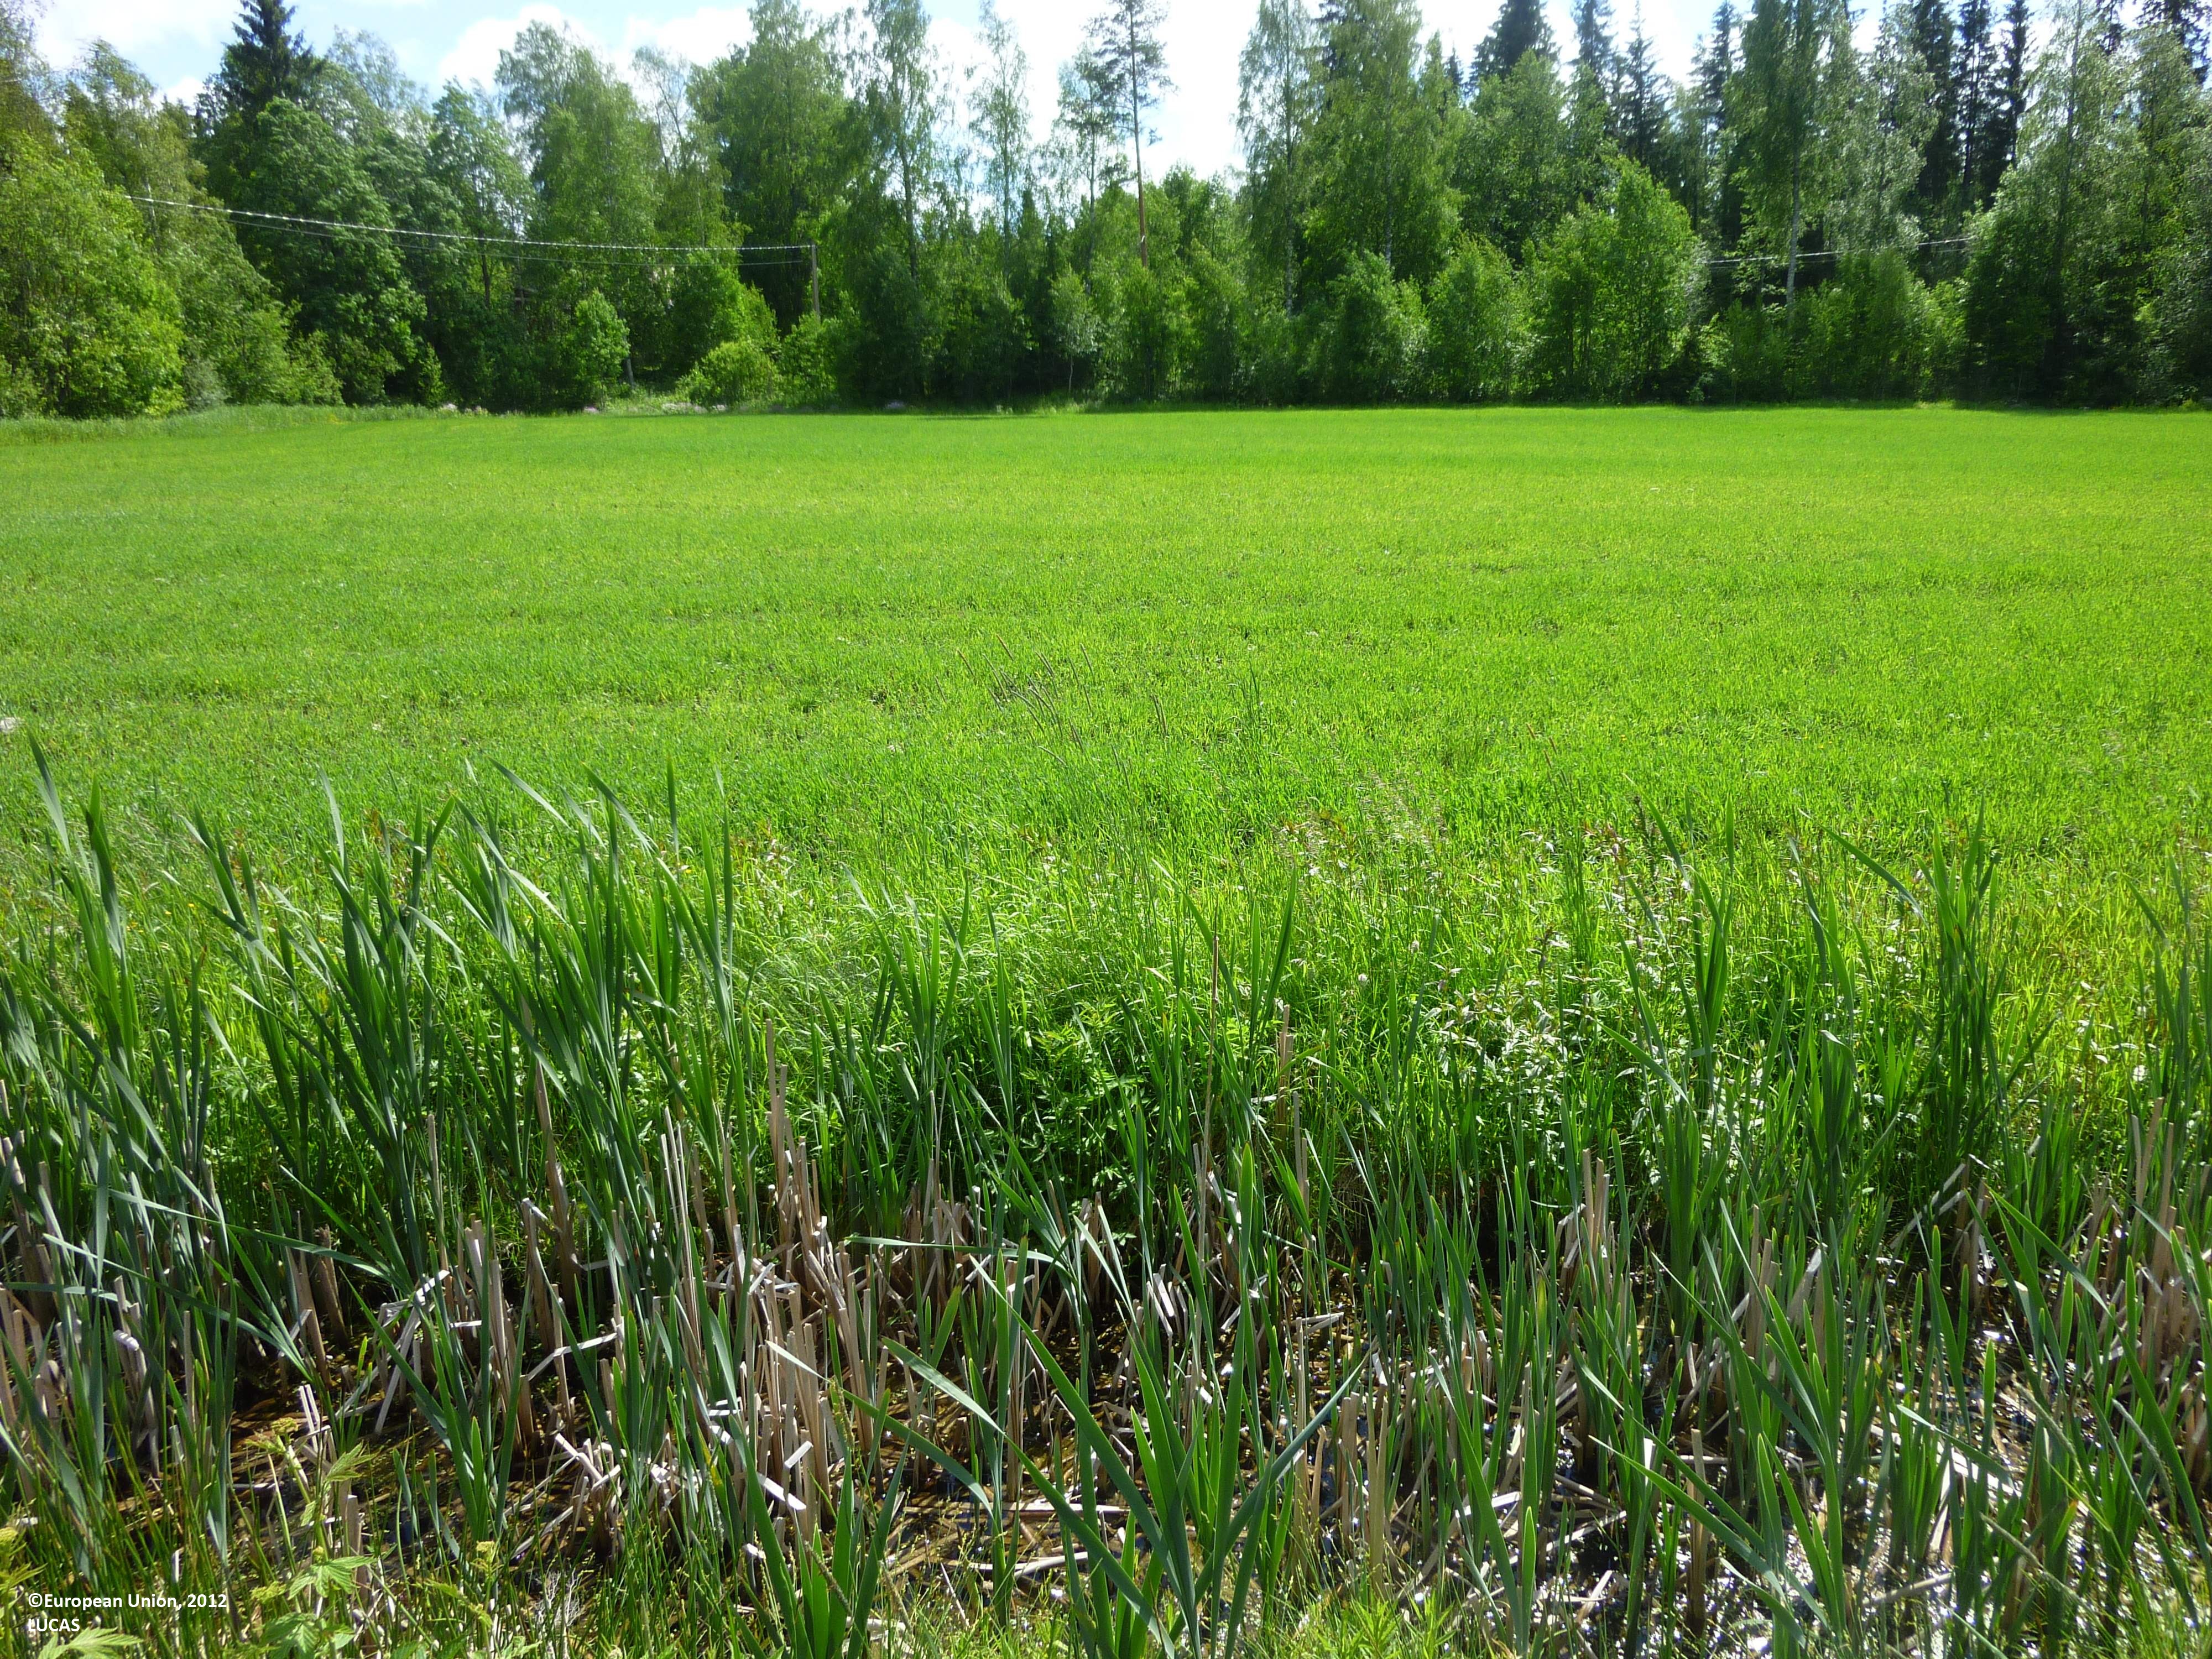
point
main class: Cropland
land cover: Barley
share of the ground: > 75 %
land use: Agriculture (excluding fallow land and kitchen gardens)
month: June
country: FI
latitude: 61.7250
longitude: 22.2641
